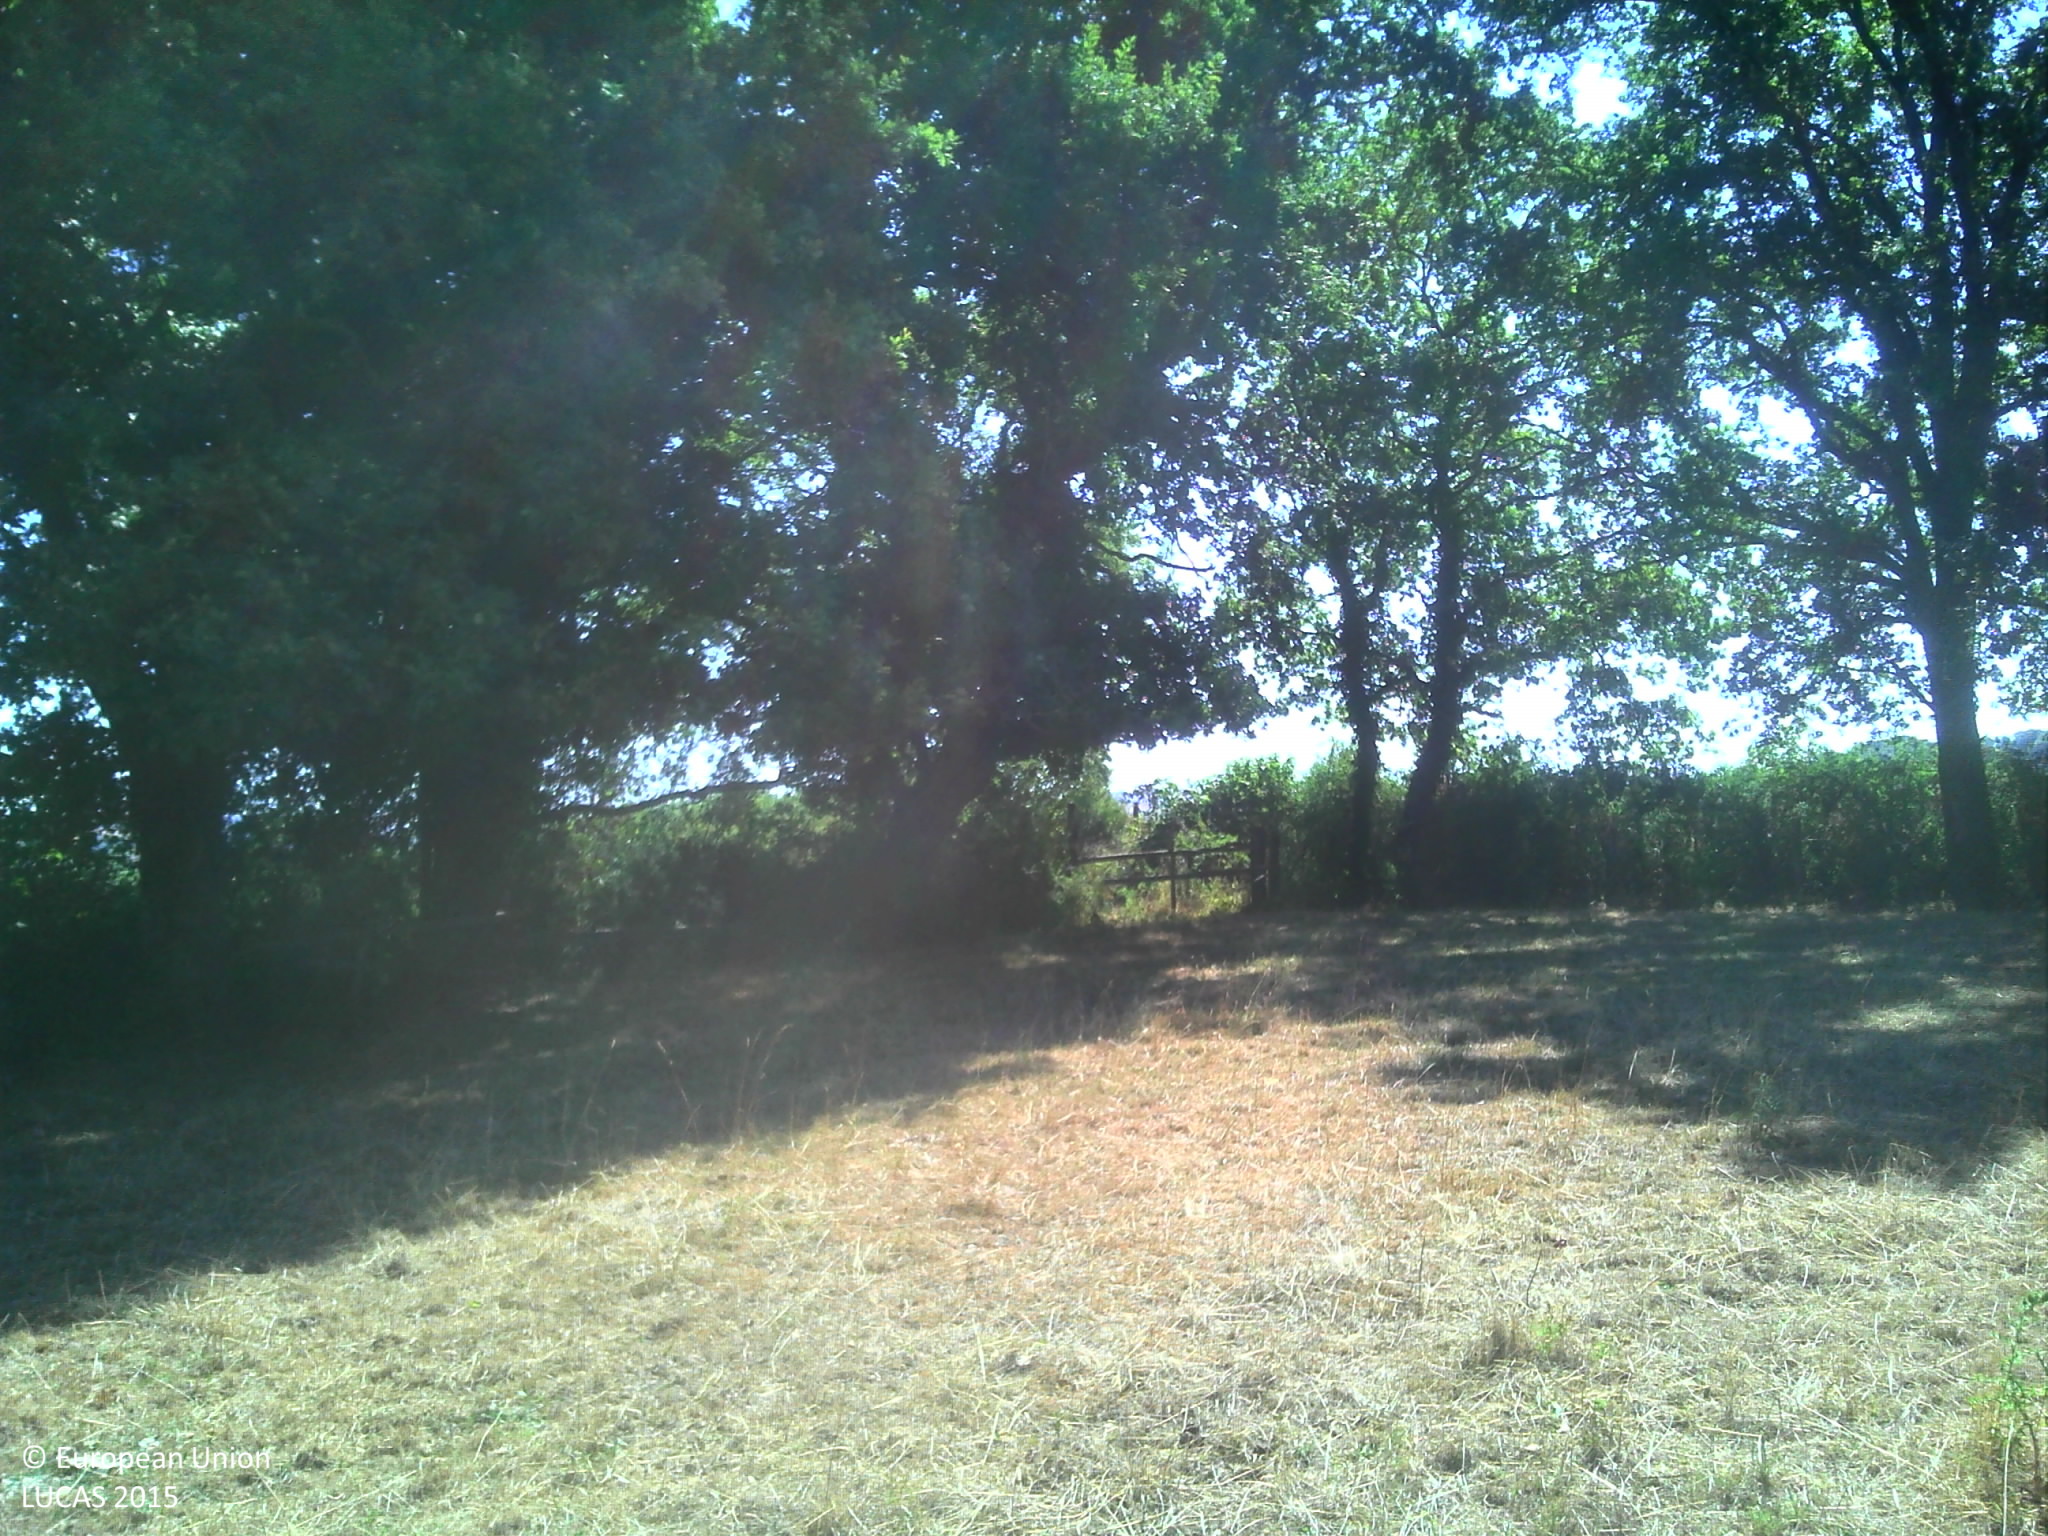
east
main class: Grassland
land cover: Grassland without tree/shrub cover
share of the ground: > 75 %
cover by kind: herbaceous plants 100 %
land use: Agriculture (excluding fallow land and kitchen gardens)
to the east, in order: Grassland without tree/shrub cover; Broadleaved woodland; Fences; Tracks; Broadleaved woodland; Grassland without tree/shrub cover; Managed hedges; Grassland without tree/shrub cover; Managed hedges; Grassland without tree/shrub cover; Abandoned hedges; Grassland without tree/shrub cover; Fences; Grassland without tree/shrub cover
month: August
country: FR
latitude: 46.6555
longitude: 4.3948
